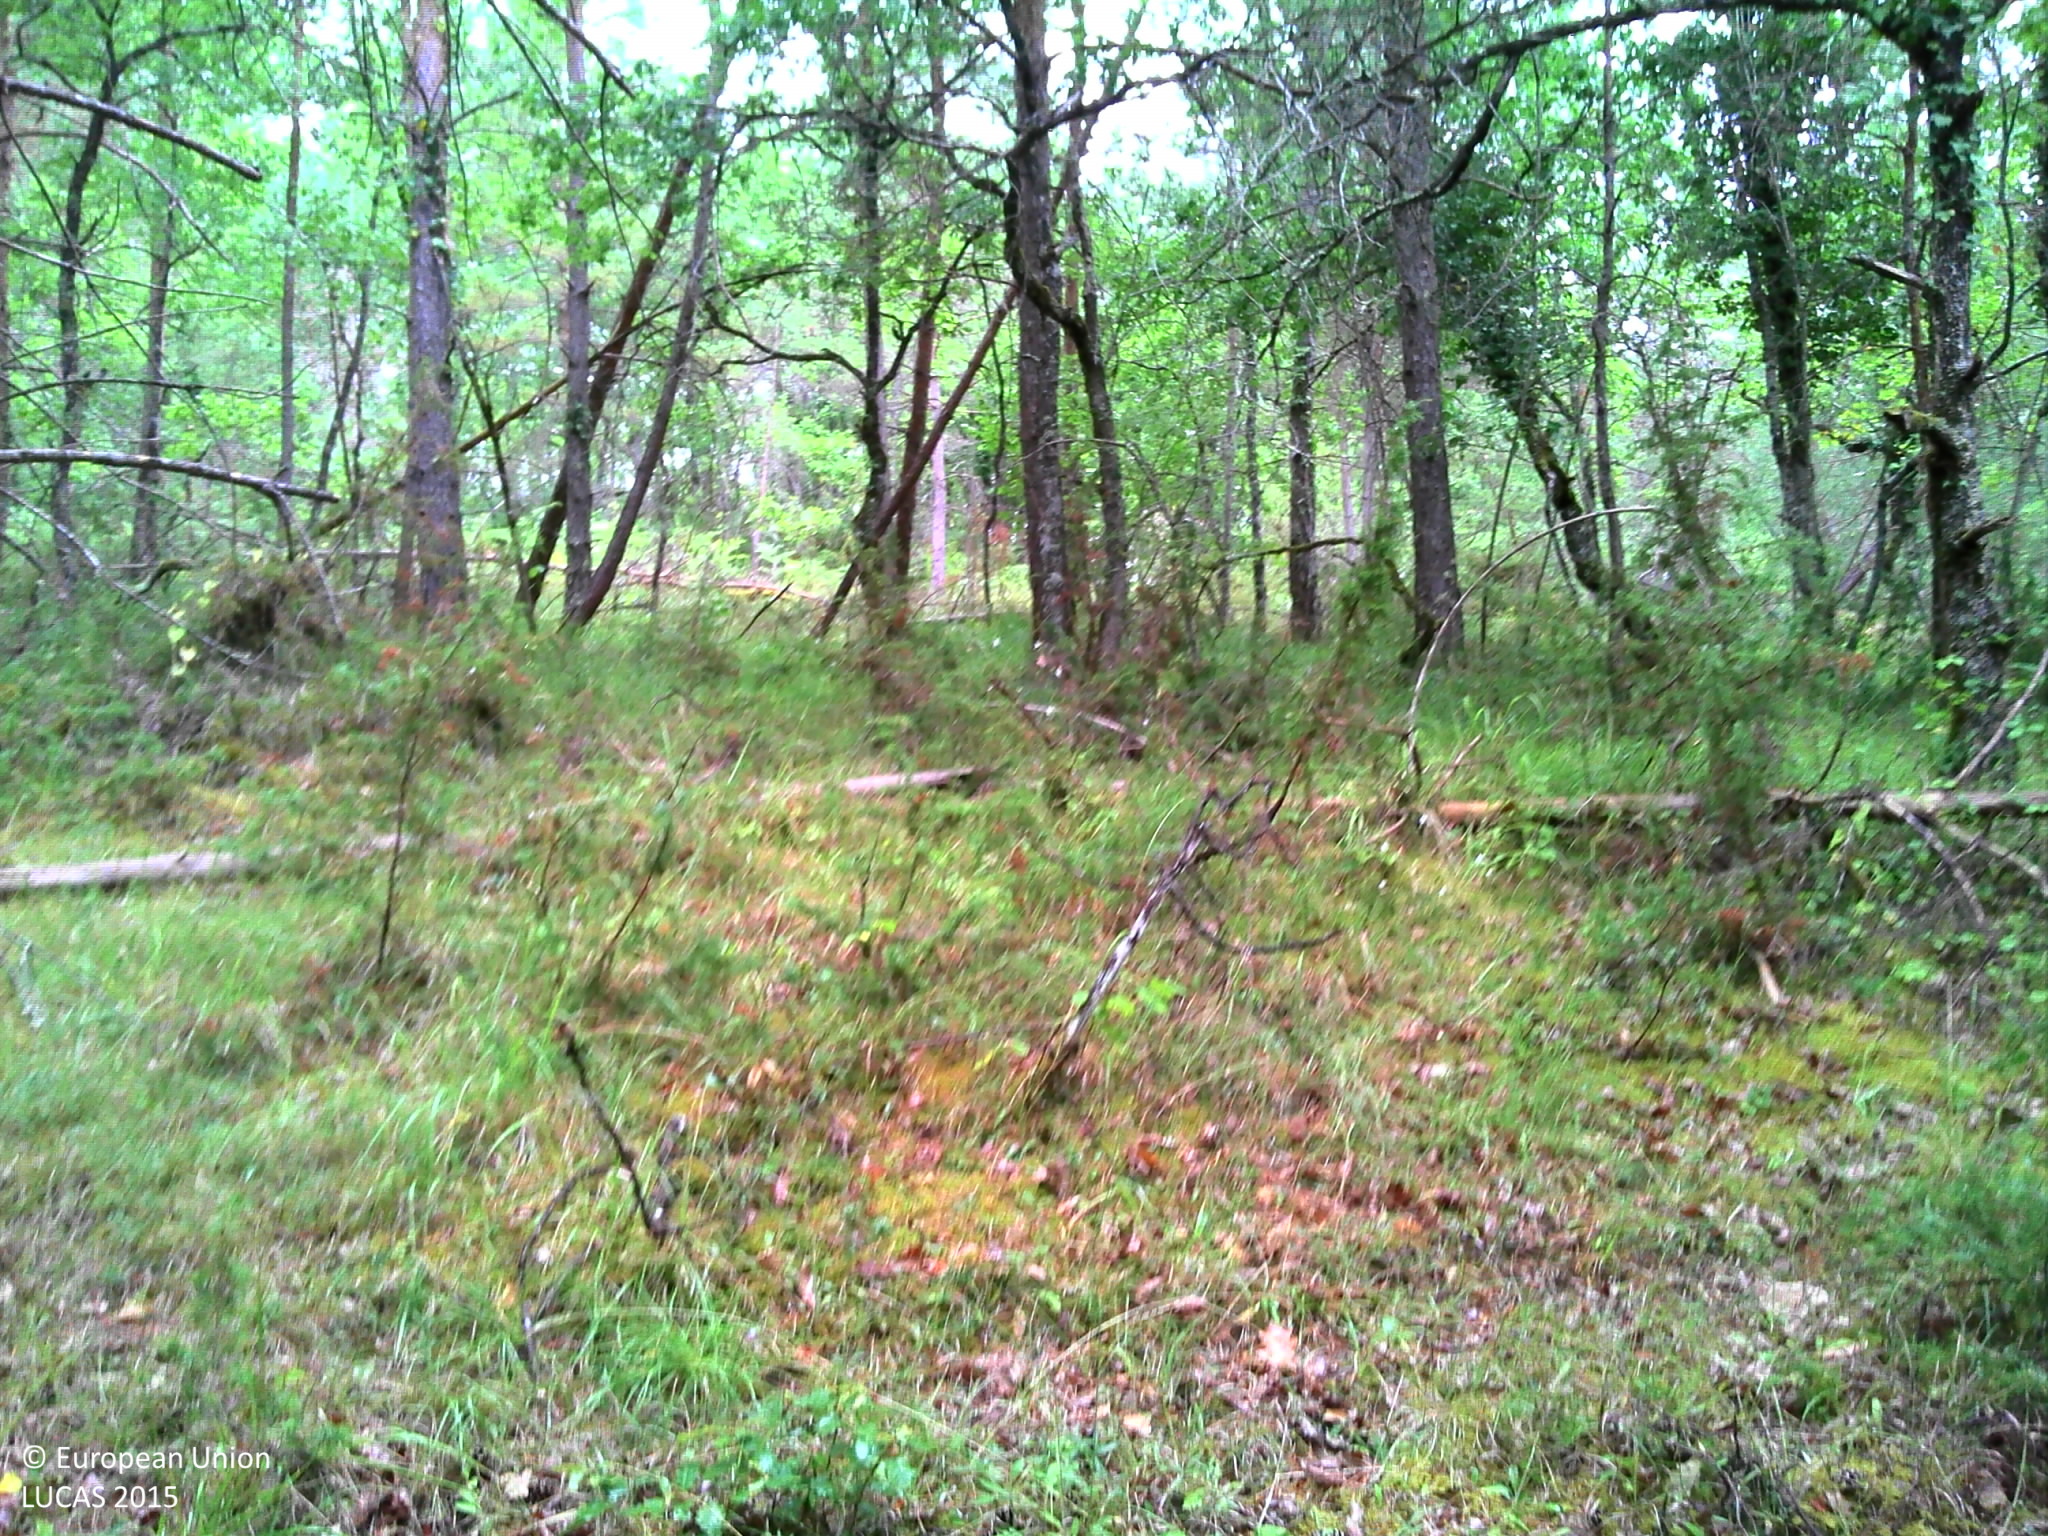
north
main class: Woodland
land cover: Pine dominated mixed woodland
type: hemiboreal forest and nemoral coniferous forest and mixed broadleaved-coniferous forest
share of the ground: > 75 %
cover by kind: broadleaved forest trees 50 %, coniferous forest trees 30 %, shrubs 10 %, herbaceous plants 10 %
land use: Forestry
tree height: > 5 m
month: July
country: FR
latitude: 44.9012
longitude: 0.7852
